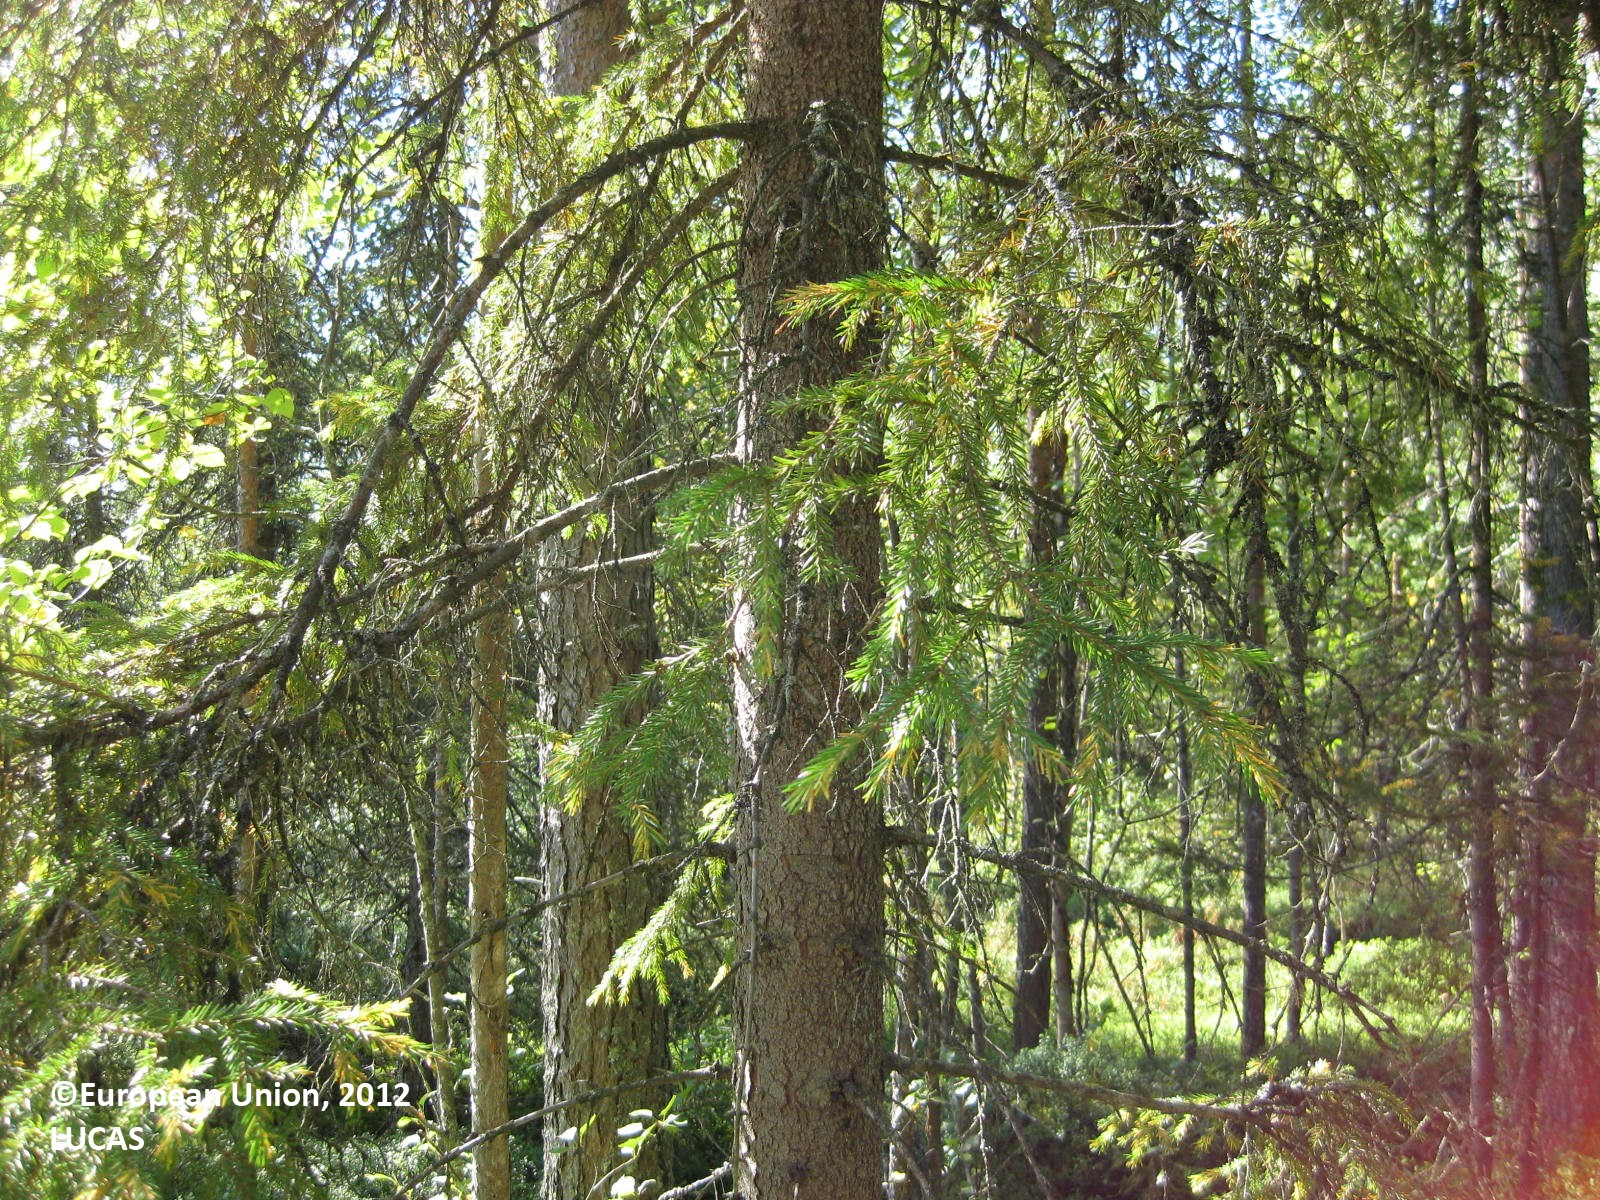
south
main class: Woodland
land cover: Other coniferous woodland
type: boreal forest
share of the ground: > 75 %
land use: Forestry
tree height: > 5 m
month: August
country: FI
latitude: 66.3557
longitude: 29.0489
